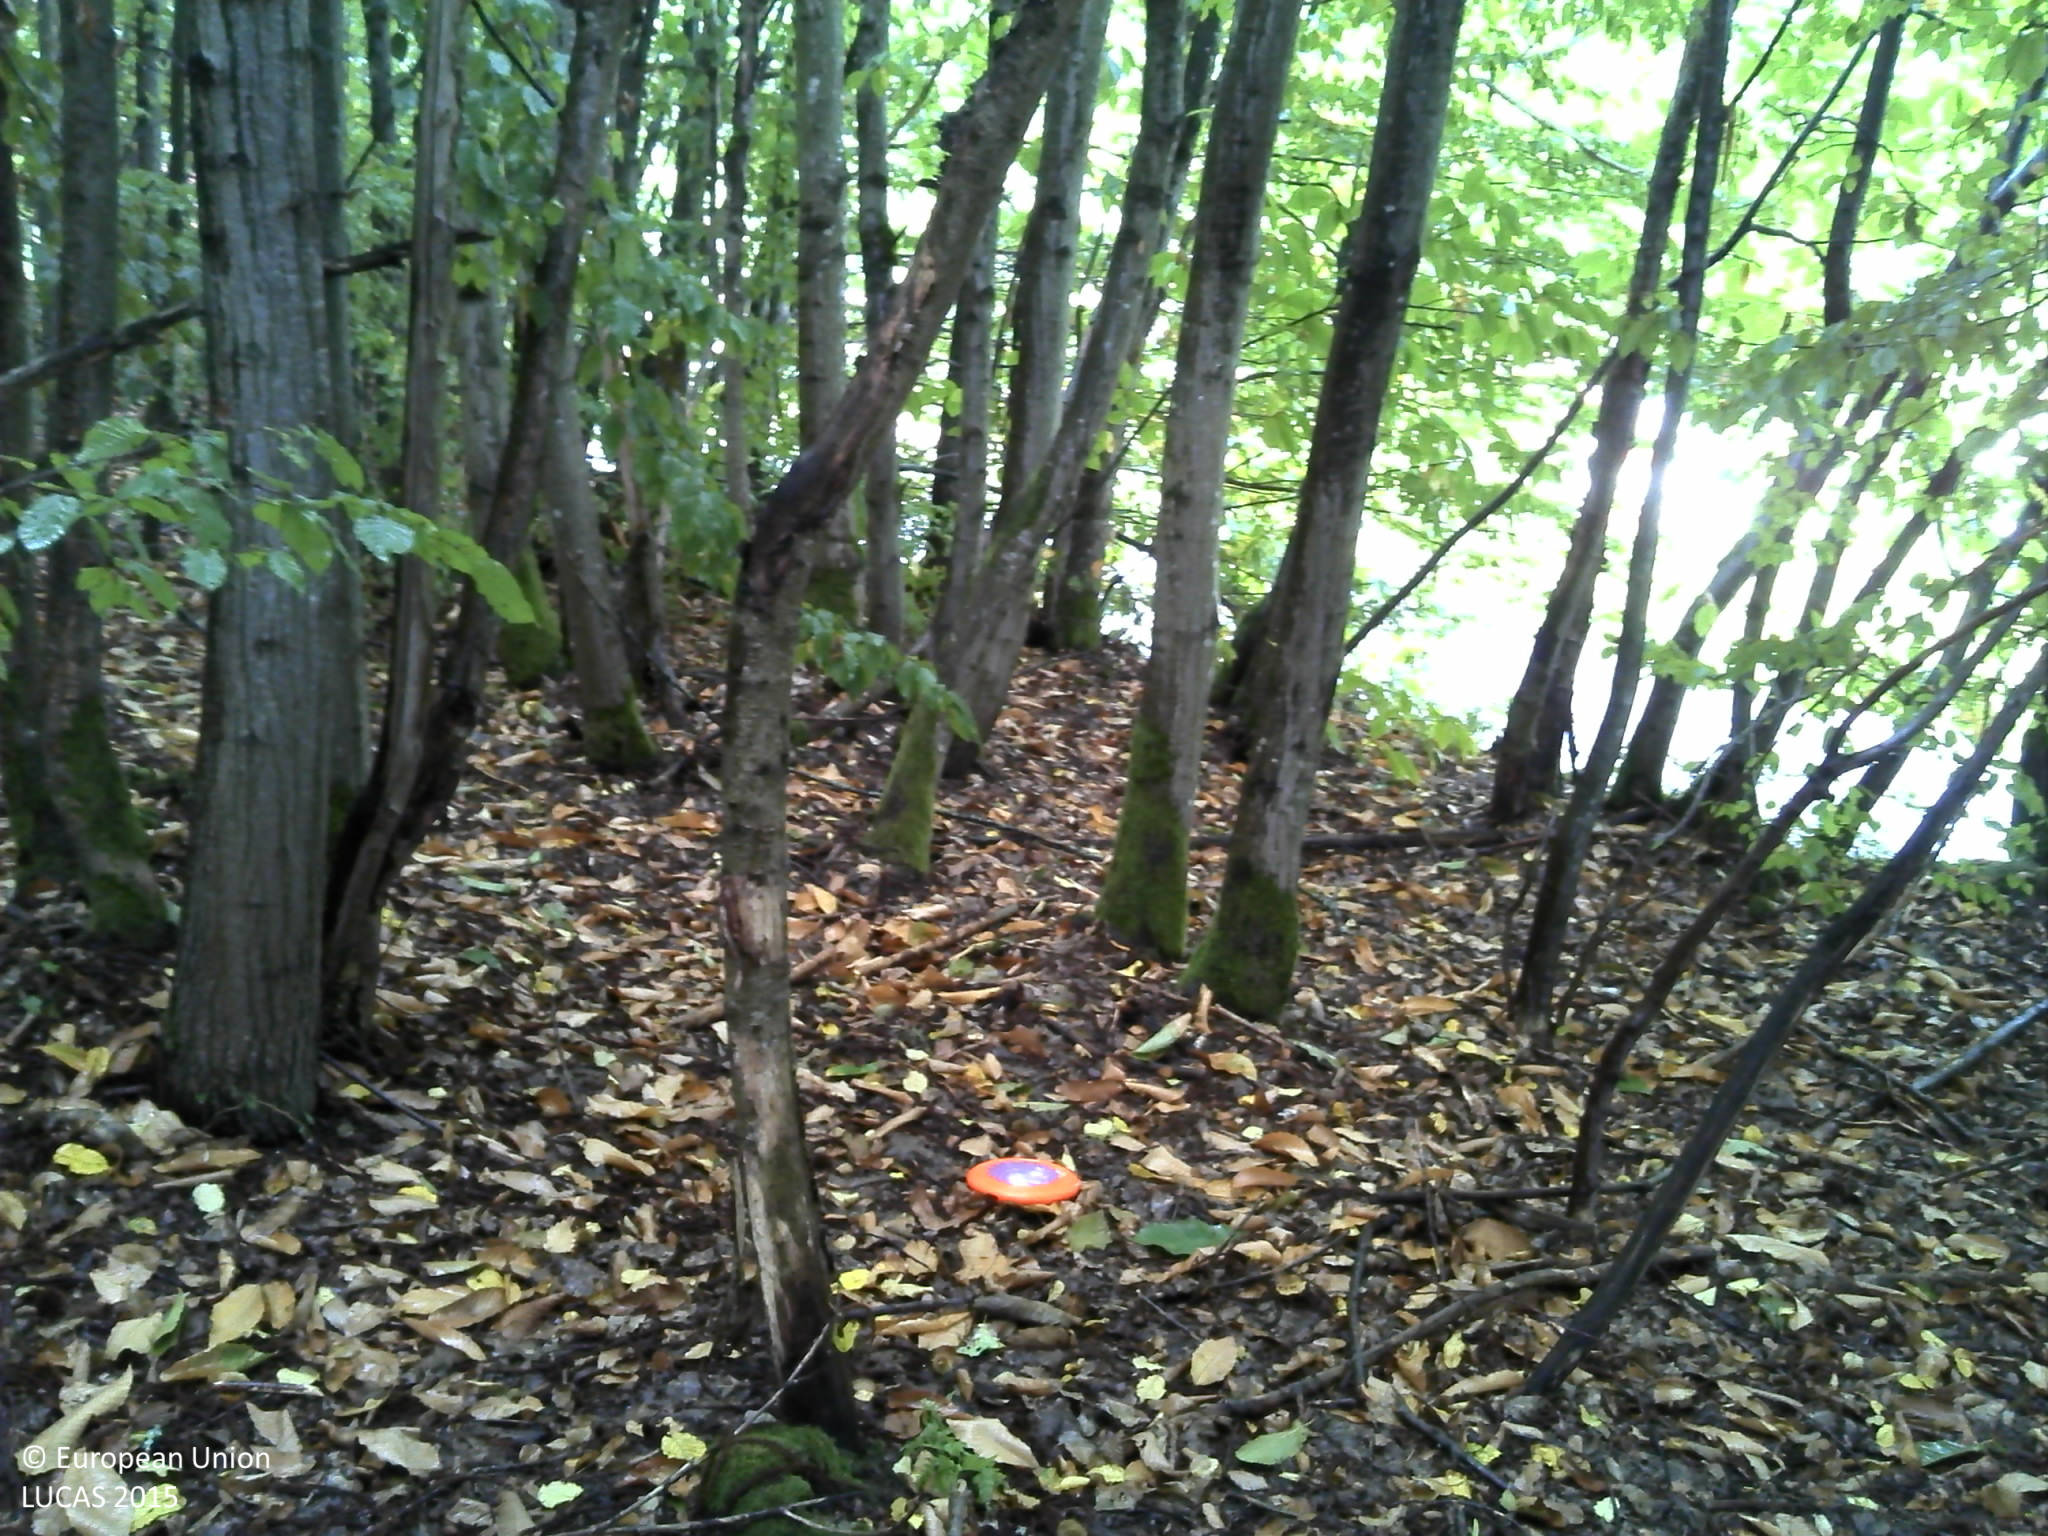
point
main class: Woodland
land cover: Broadleaved woodland
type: mesophytic deciduous forest
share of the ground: > 75 %
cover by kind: broadleaved forest trees 90 %, consolidated bare surface 10 %
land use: Forestry
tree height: > 5 m
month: September
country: FR
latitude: 48.3523
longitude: 7.2885
